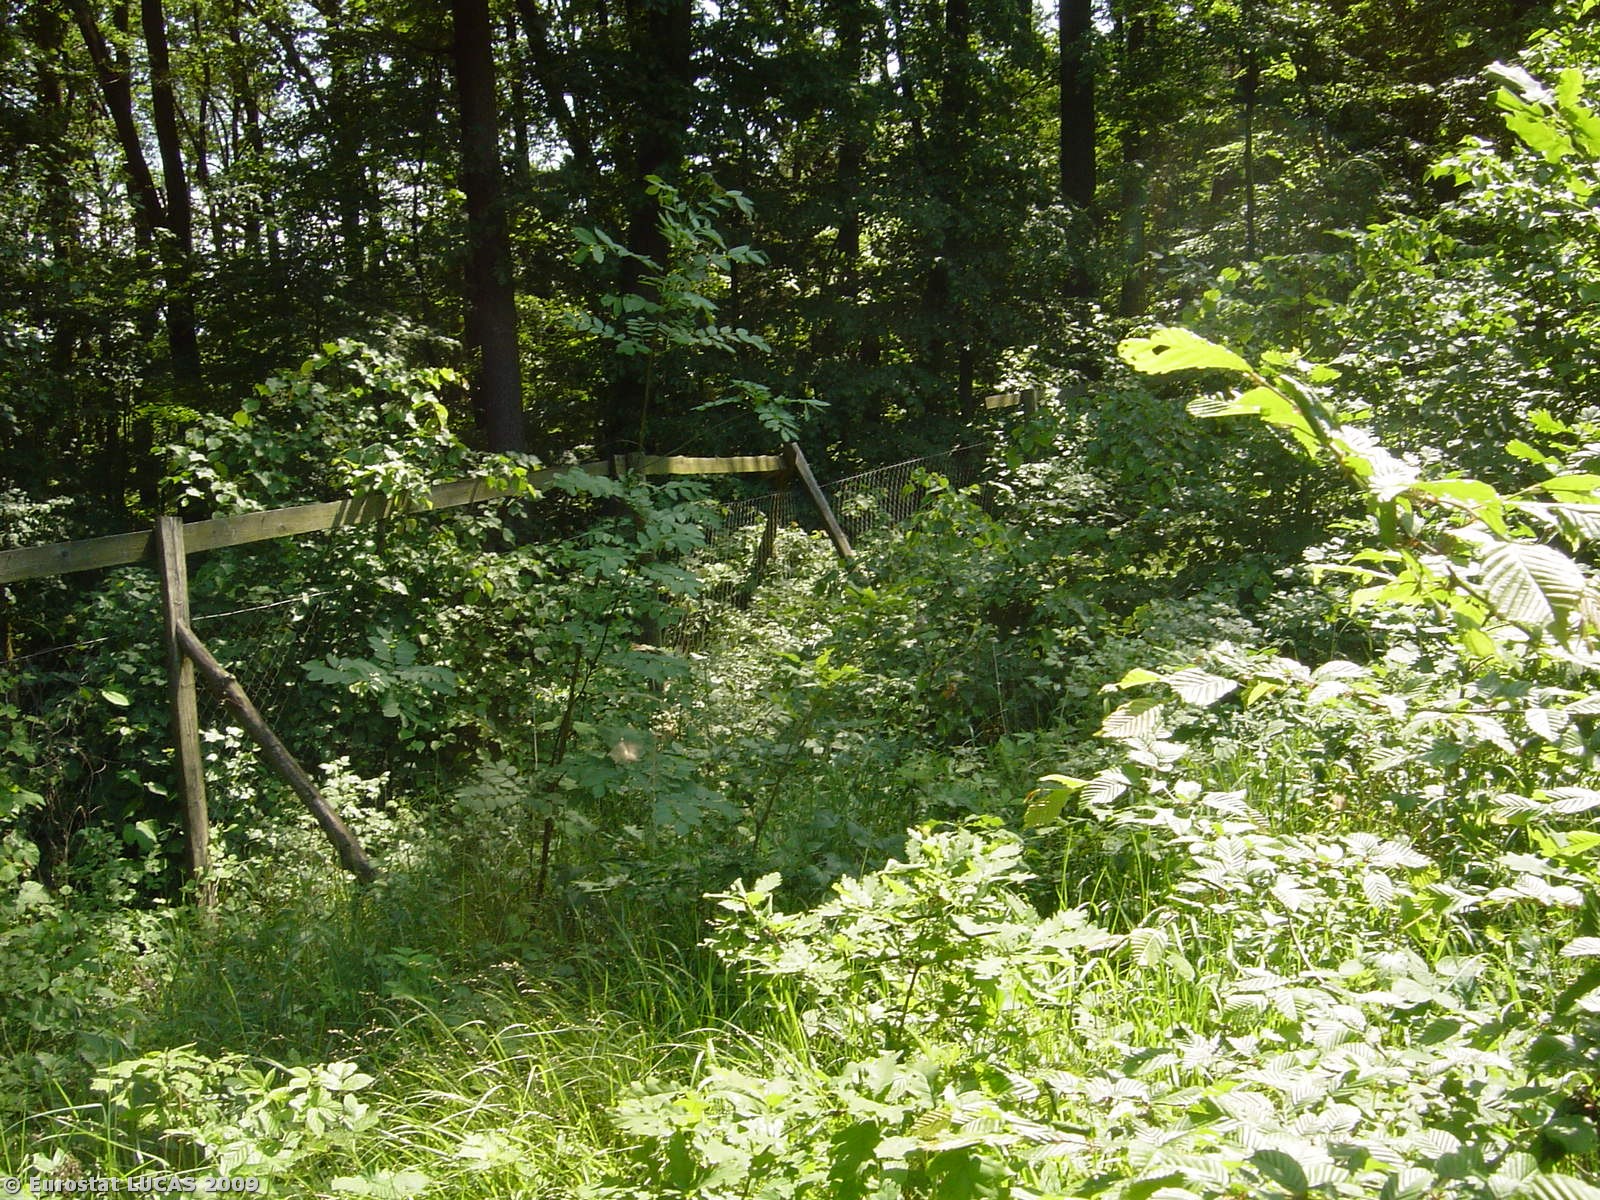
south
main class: Woodland
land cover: Broadleaved woodland
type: mesophytic deciduous forest
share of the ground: > 75 %
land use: Forestry
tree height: > 5 m
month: May
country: CZ
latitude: 49.0772
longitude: 17.1147
